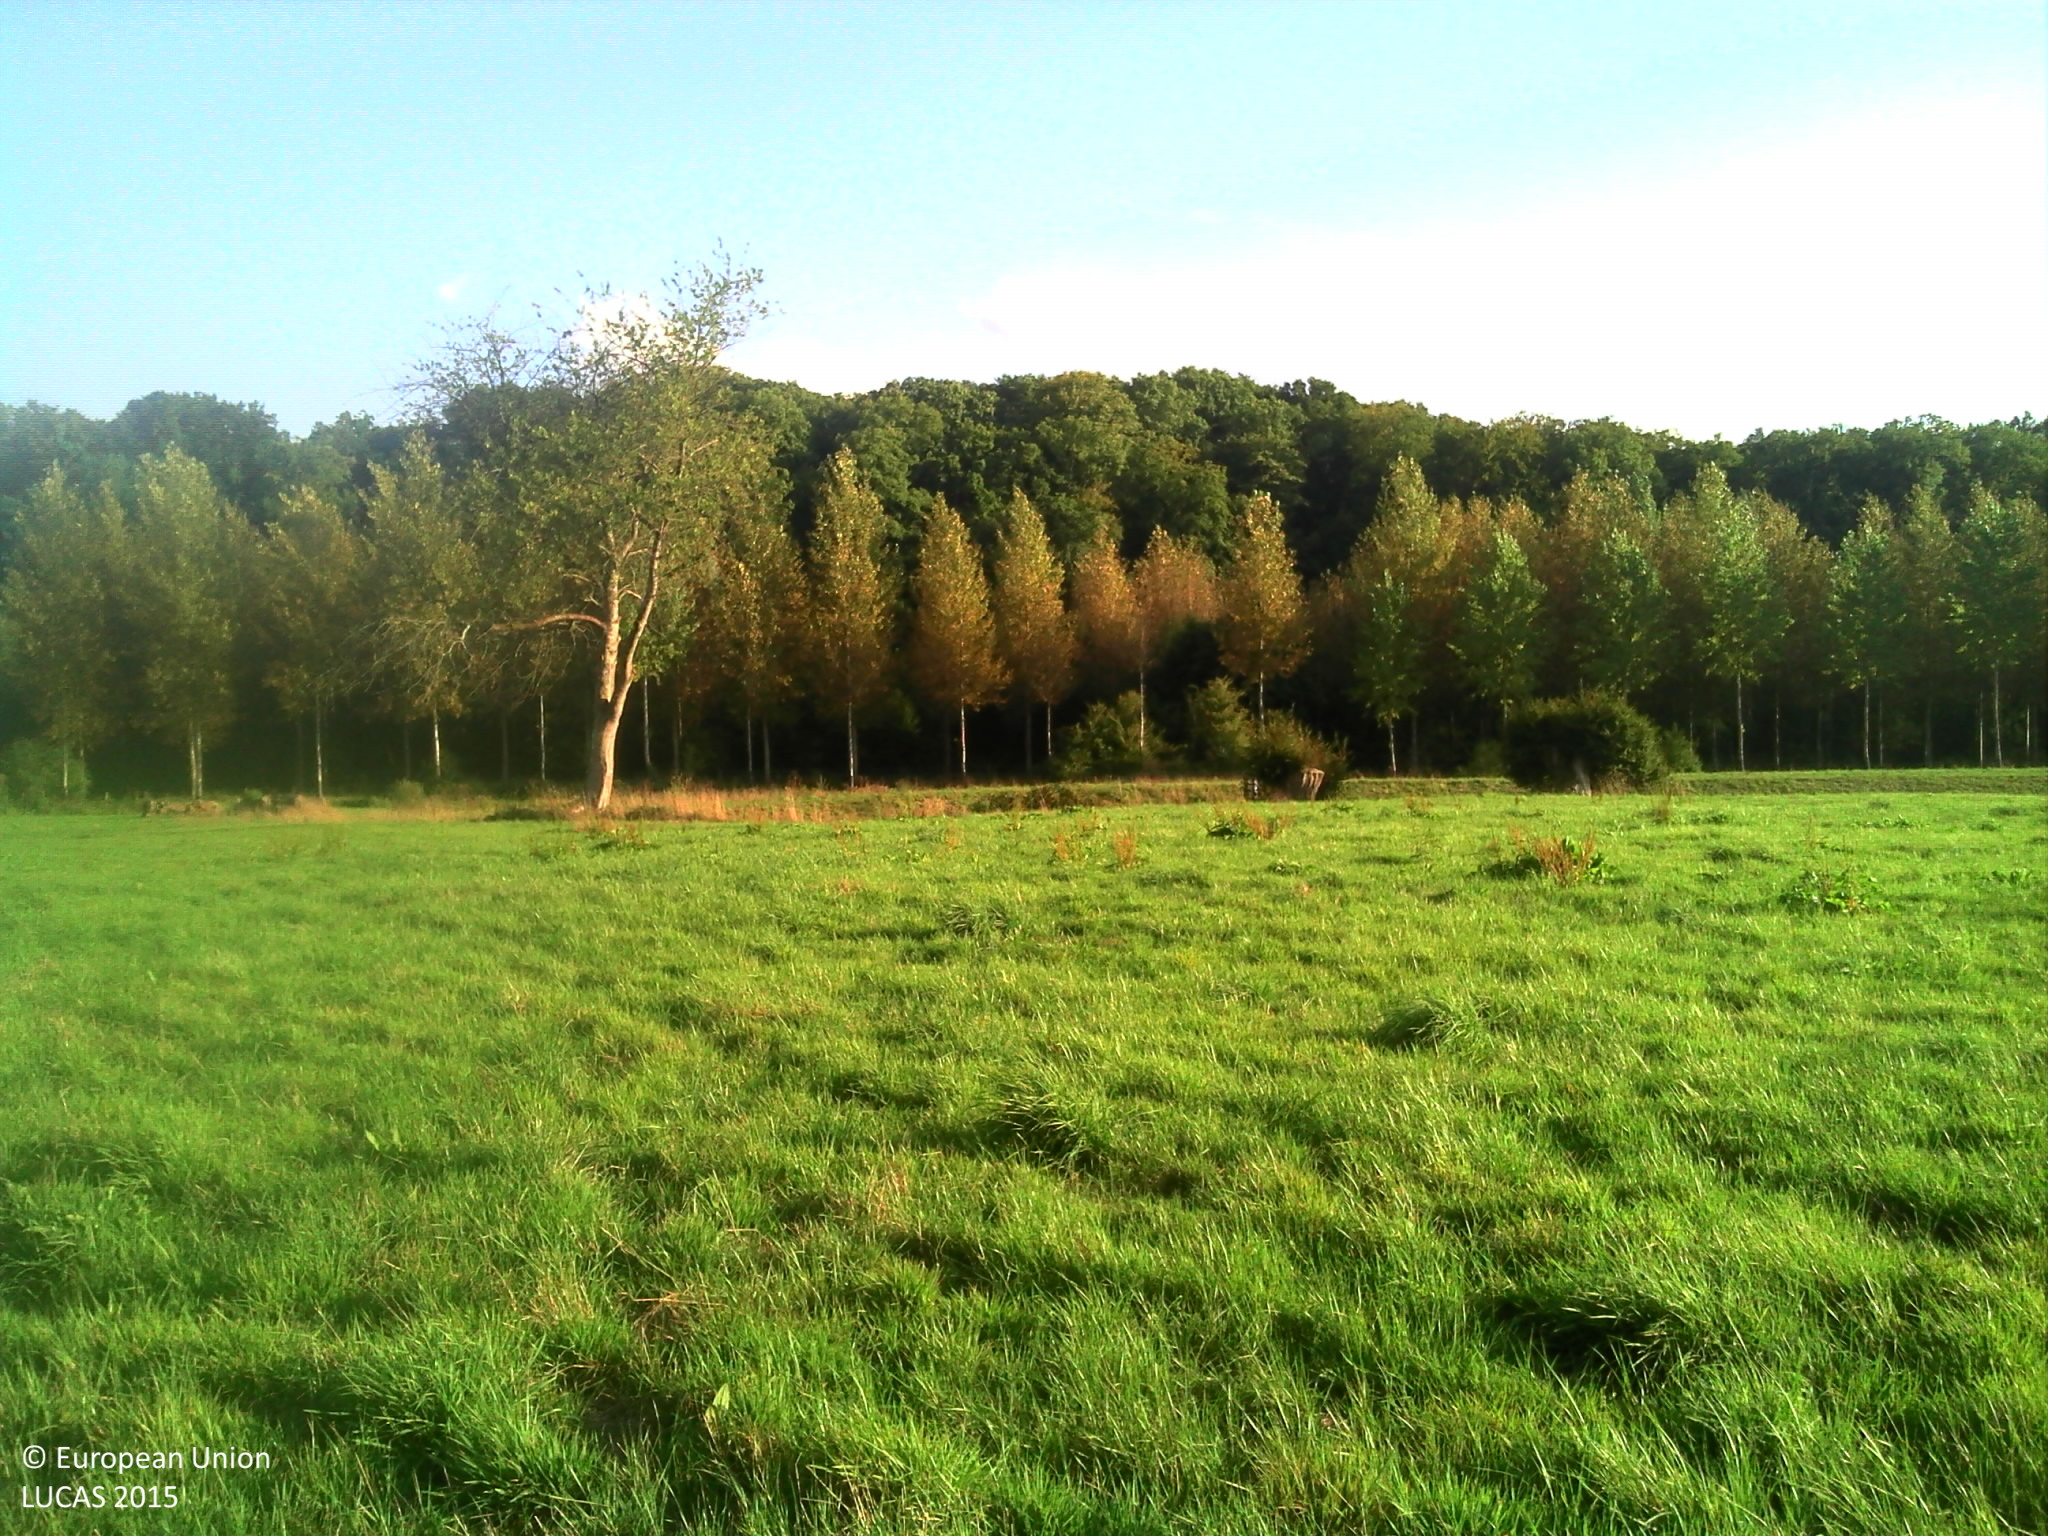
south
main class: Grassland
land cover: Grassland without tree/shrub cover
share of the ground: > 75 %
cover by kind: herbaceous plants 100 %
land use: Agriculture (excluding fallow land and kitchen gardens)
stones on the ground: < 10 %
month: September
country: FR
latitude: 48.4107
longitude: 0.5049
